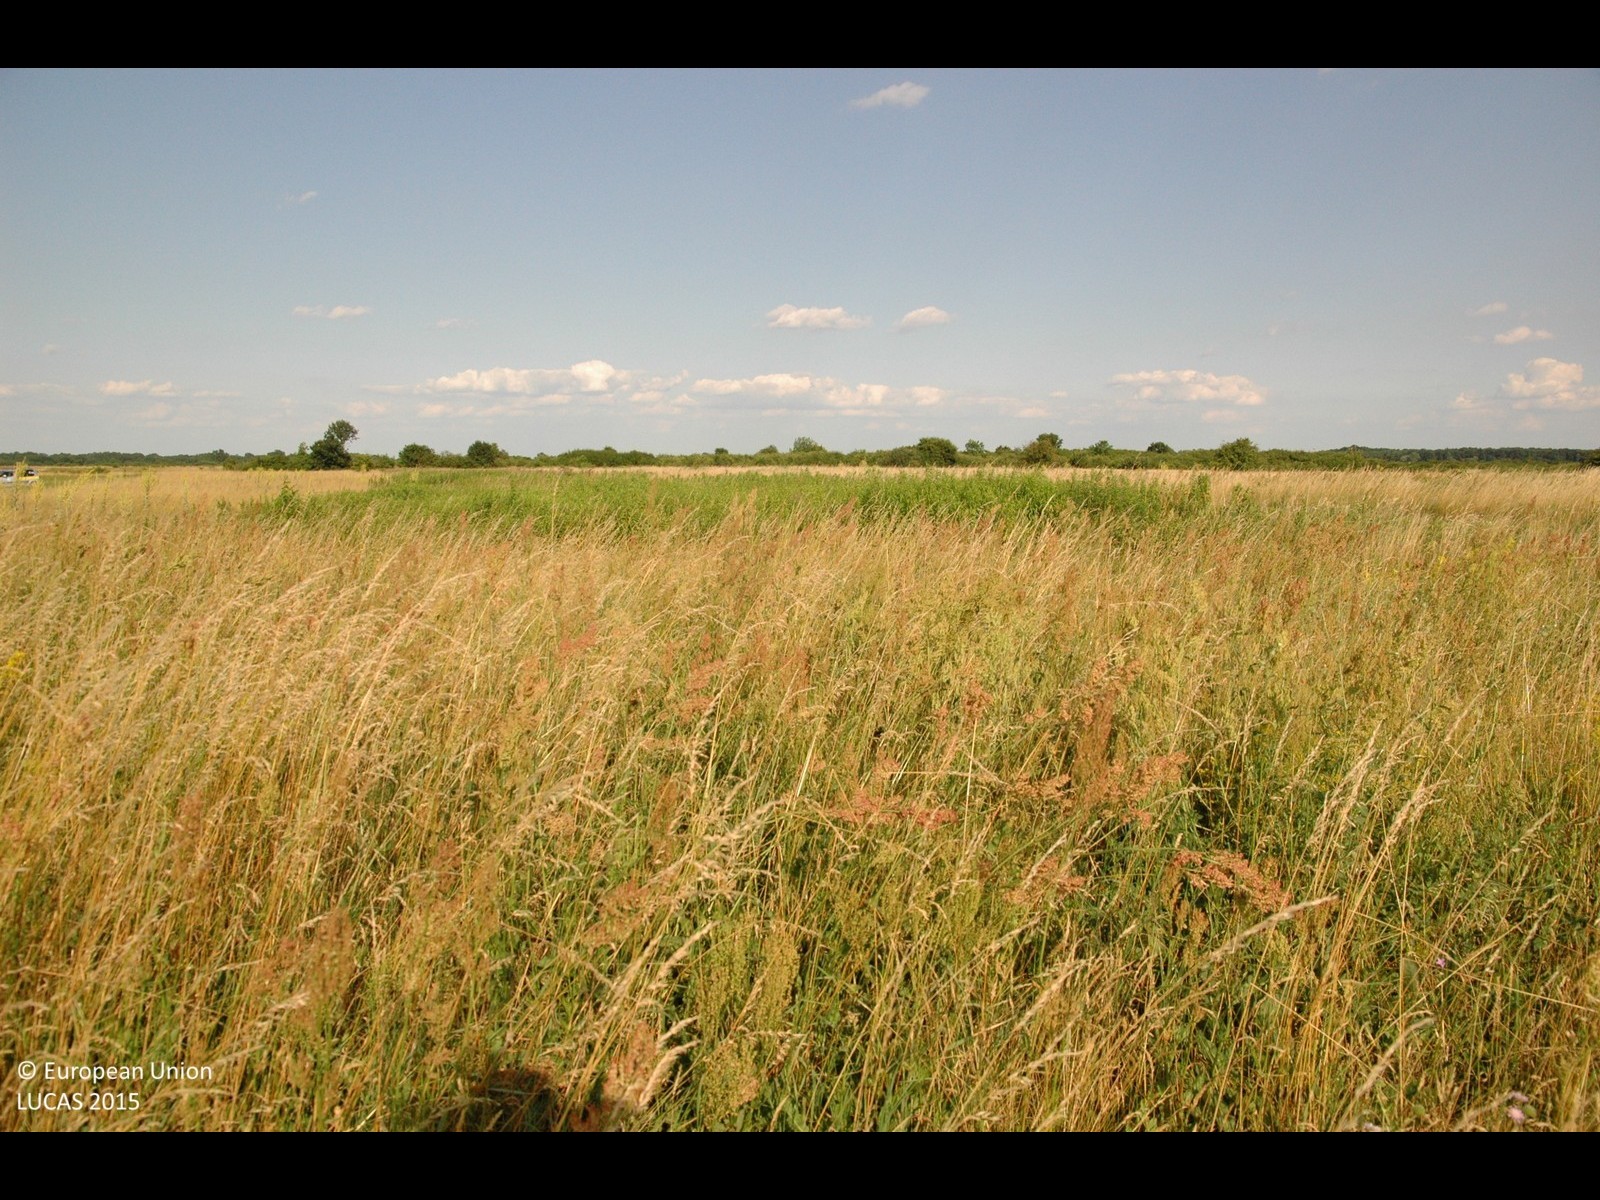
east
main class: Grassland
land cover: Grassland without tree/shrub cover
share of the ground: > 75 %
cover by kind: herbaceous plants 100 %
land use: Agriculture (excluding fallow land and kitchen gardens)
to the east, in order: Grassland without tree/shrub cover; Spontaneously vegetated surfaces; Tracks; Grassland without tree/shrub cover; Potatoes; Grassland without tree/shrub cover; Shrubland with sparse tree cover; Grassland without tree/shrub cover
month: June
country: HR
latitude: 46.3890
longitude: 16.4897
